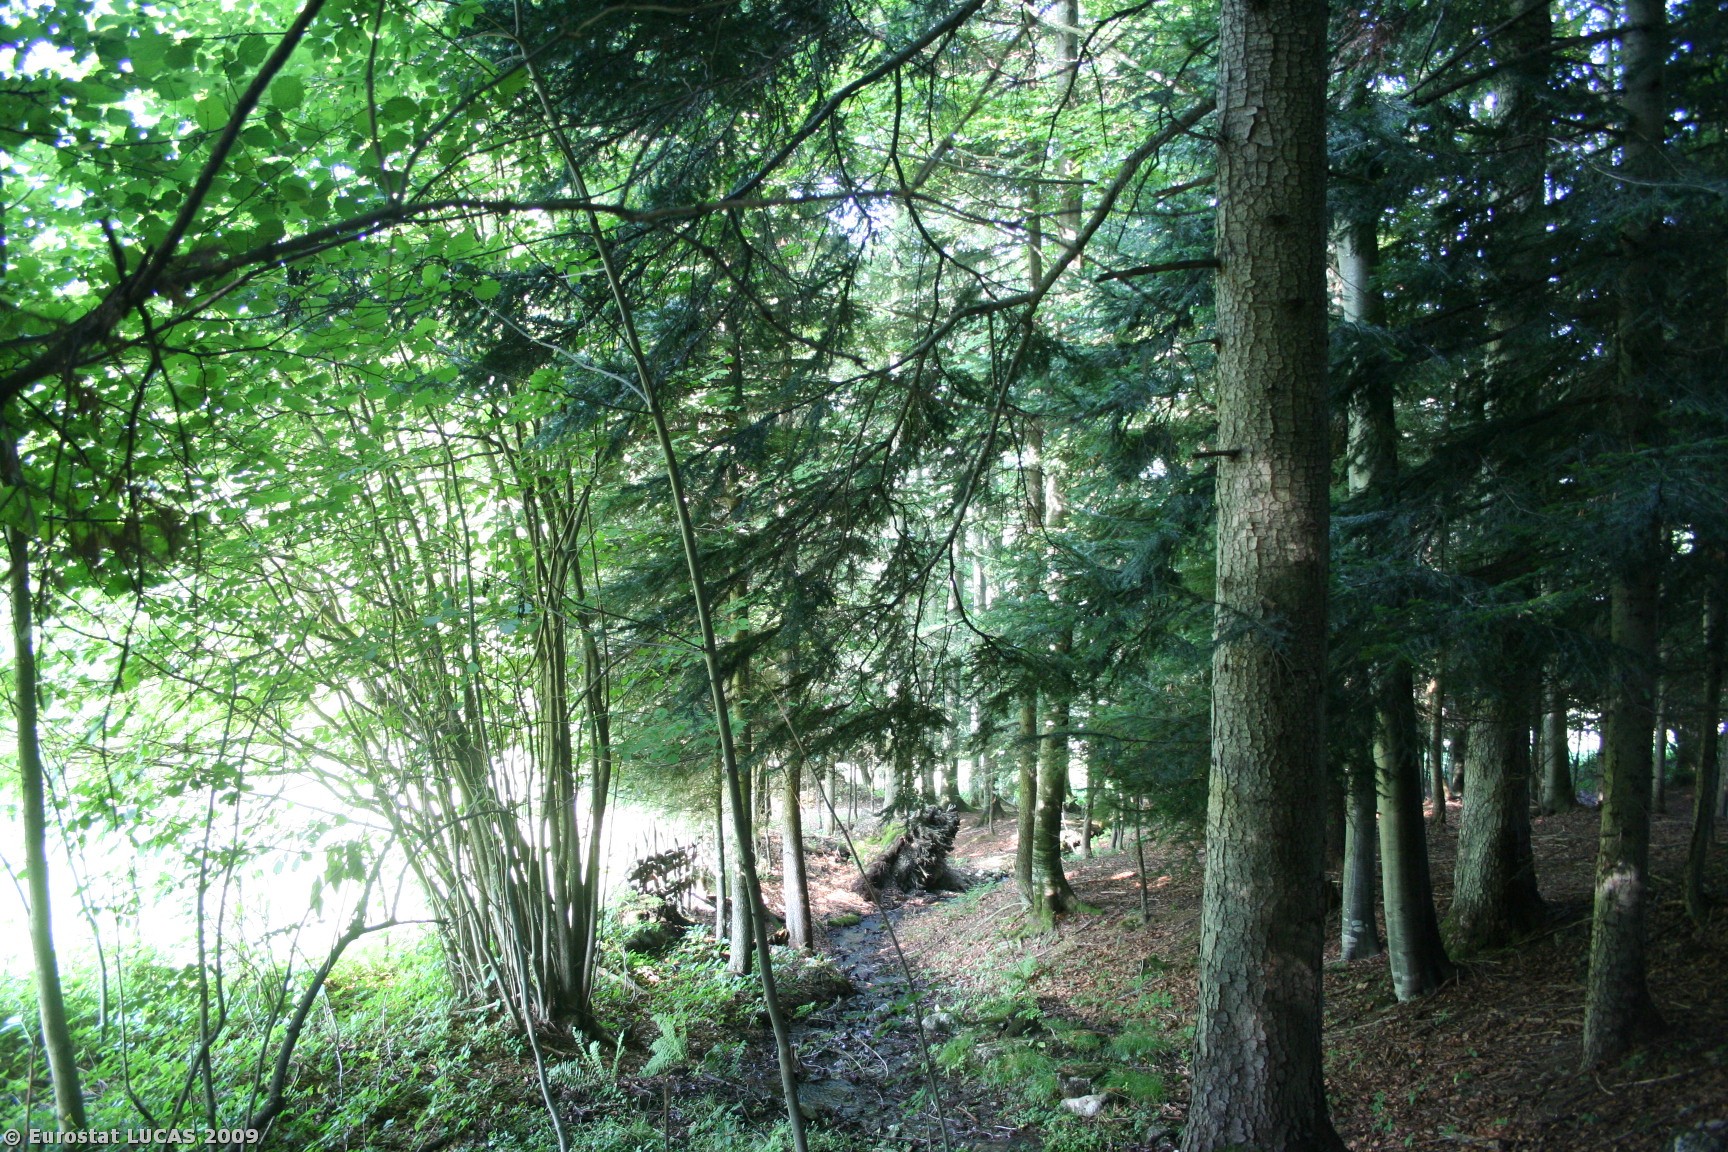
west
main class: Woodland
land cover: Mixed woodland
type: hemiboreal forest and nemoral coniferous forest and mixed broadleaved-coniferous forest
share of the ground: > 75 %
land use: Forestry
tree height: > 5 m
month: August
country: AT
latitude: 47.7085
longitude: 13.2106
